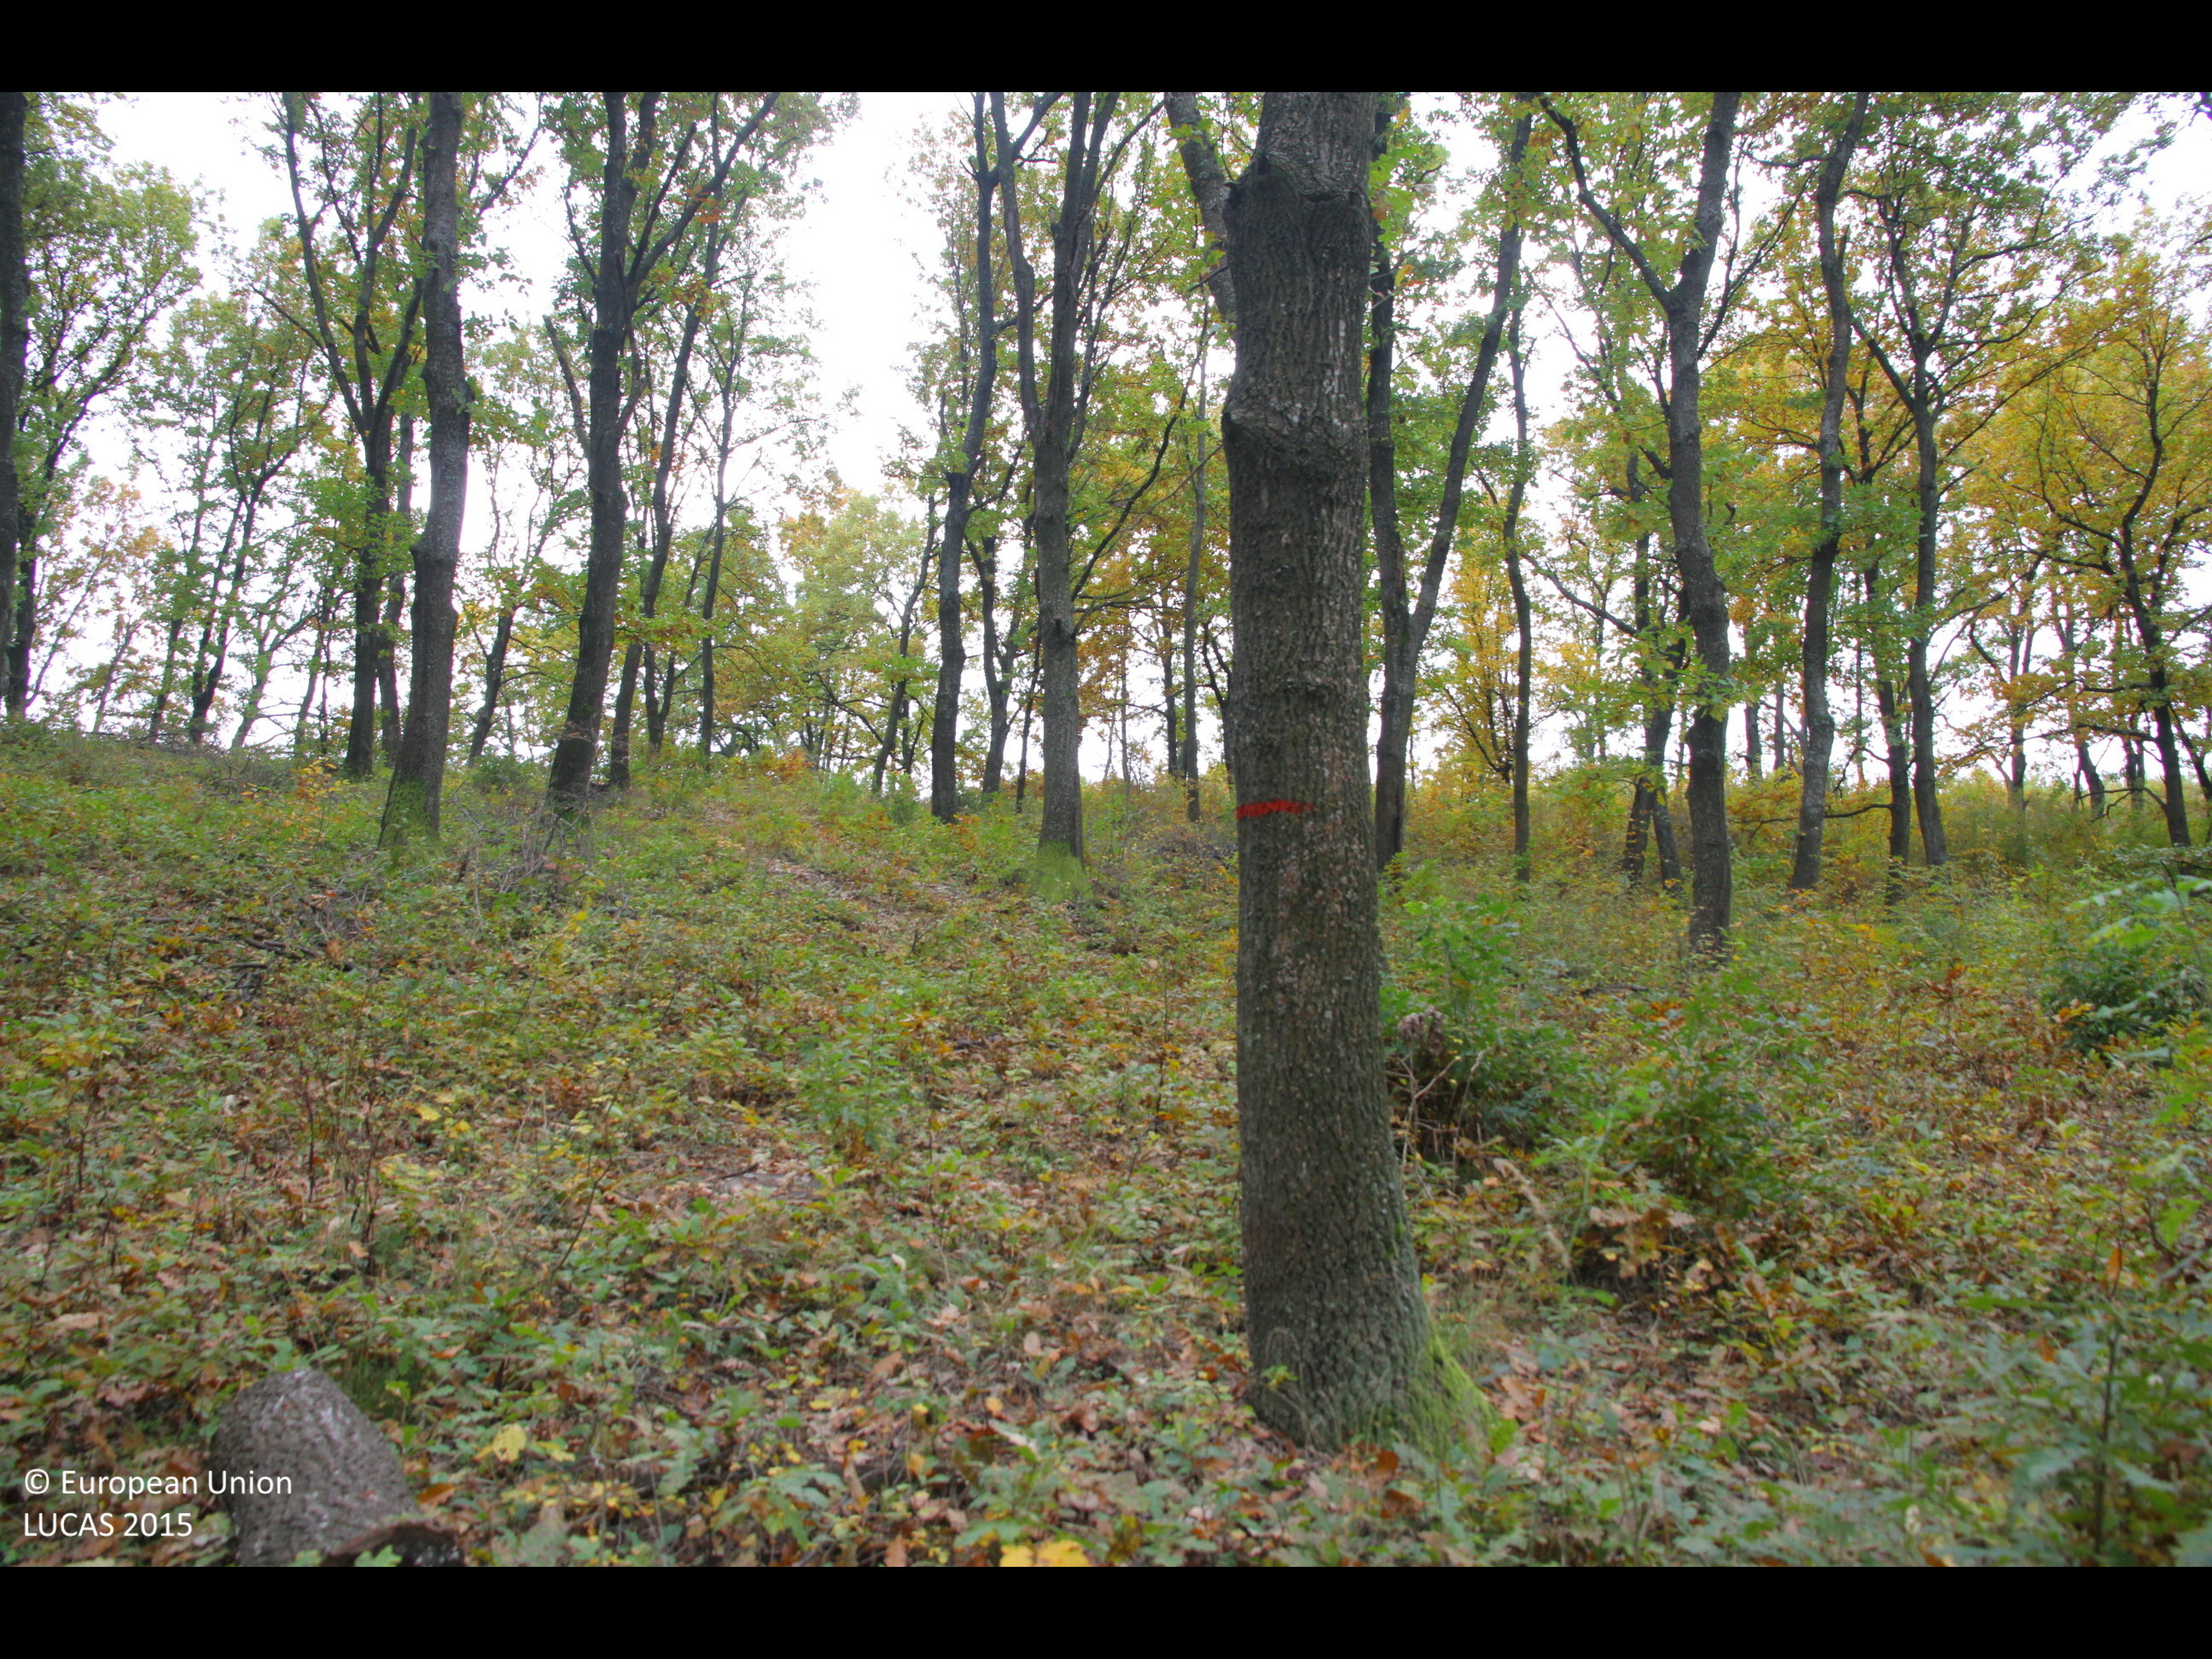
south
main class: Woodland
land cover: Broadleaved woodland
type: mesophytic deciduous forest
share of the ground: > 75 %
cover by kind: broadleaved forest trees 80 %, unconsolidated bare surface 10 %, shrubs 5 %, herbaceous plants 5 %
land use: Forestry
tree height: > 5 m
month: October
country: BG
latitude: 43.5244
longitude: 26.7776
